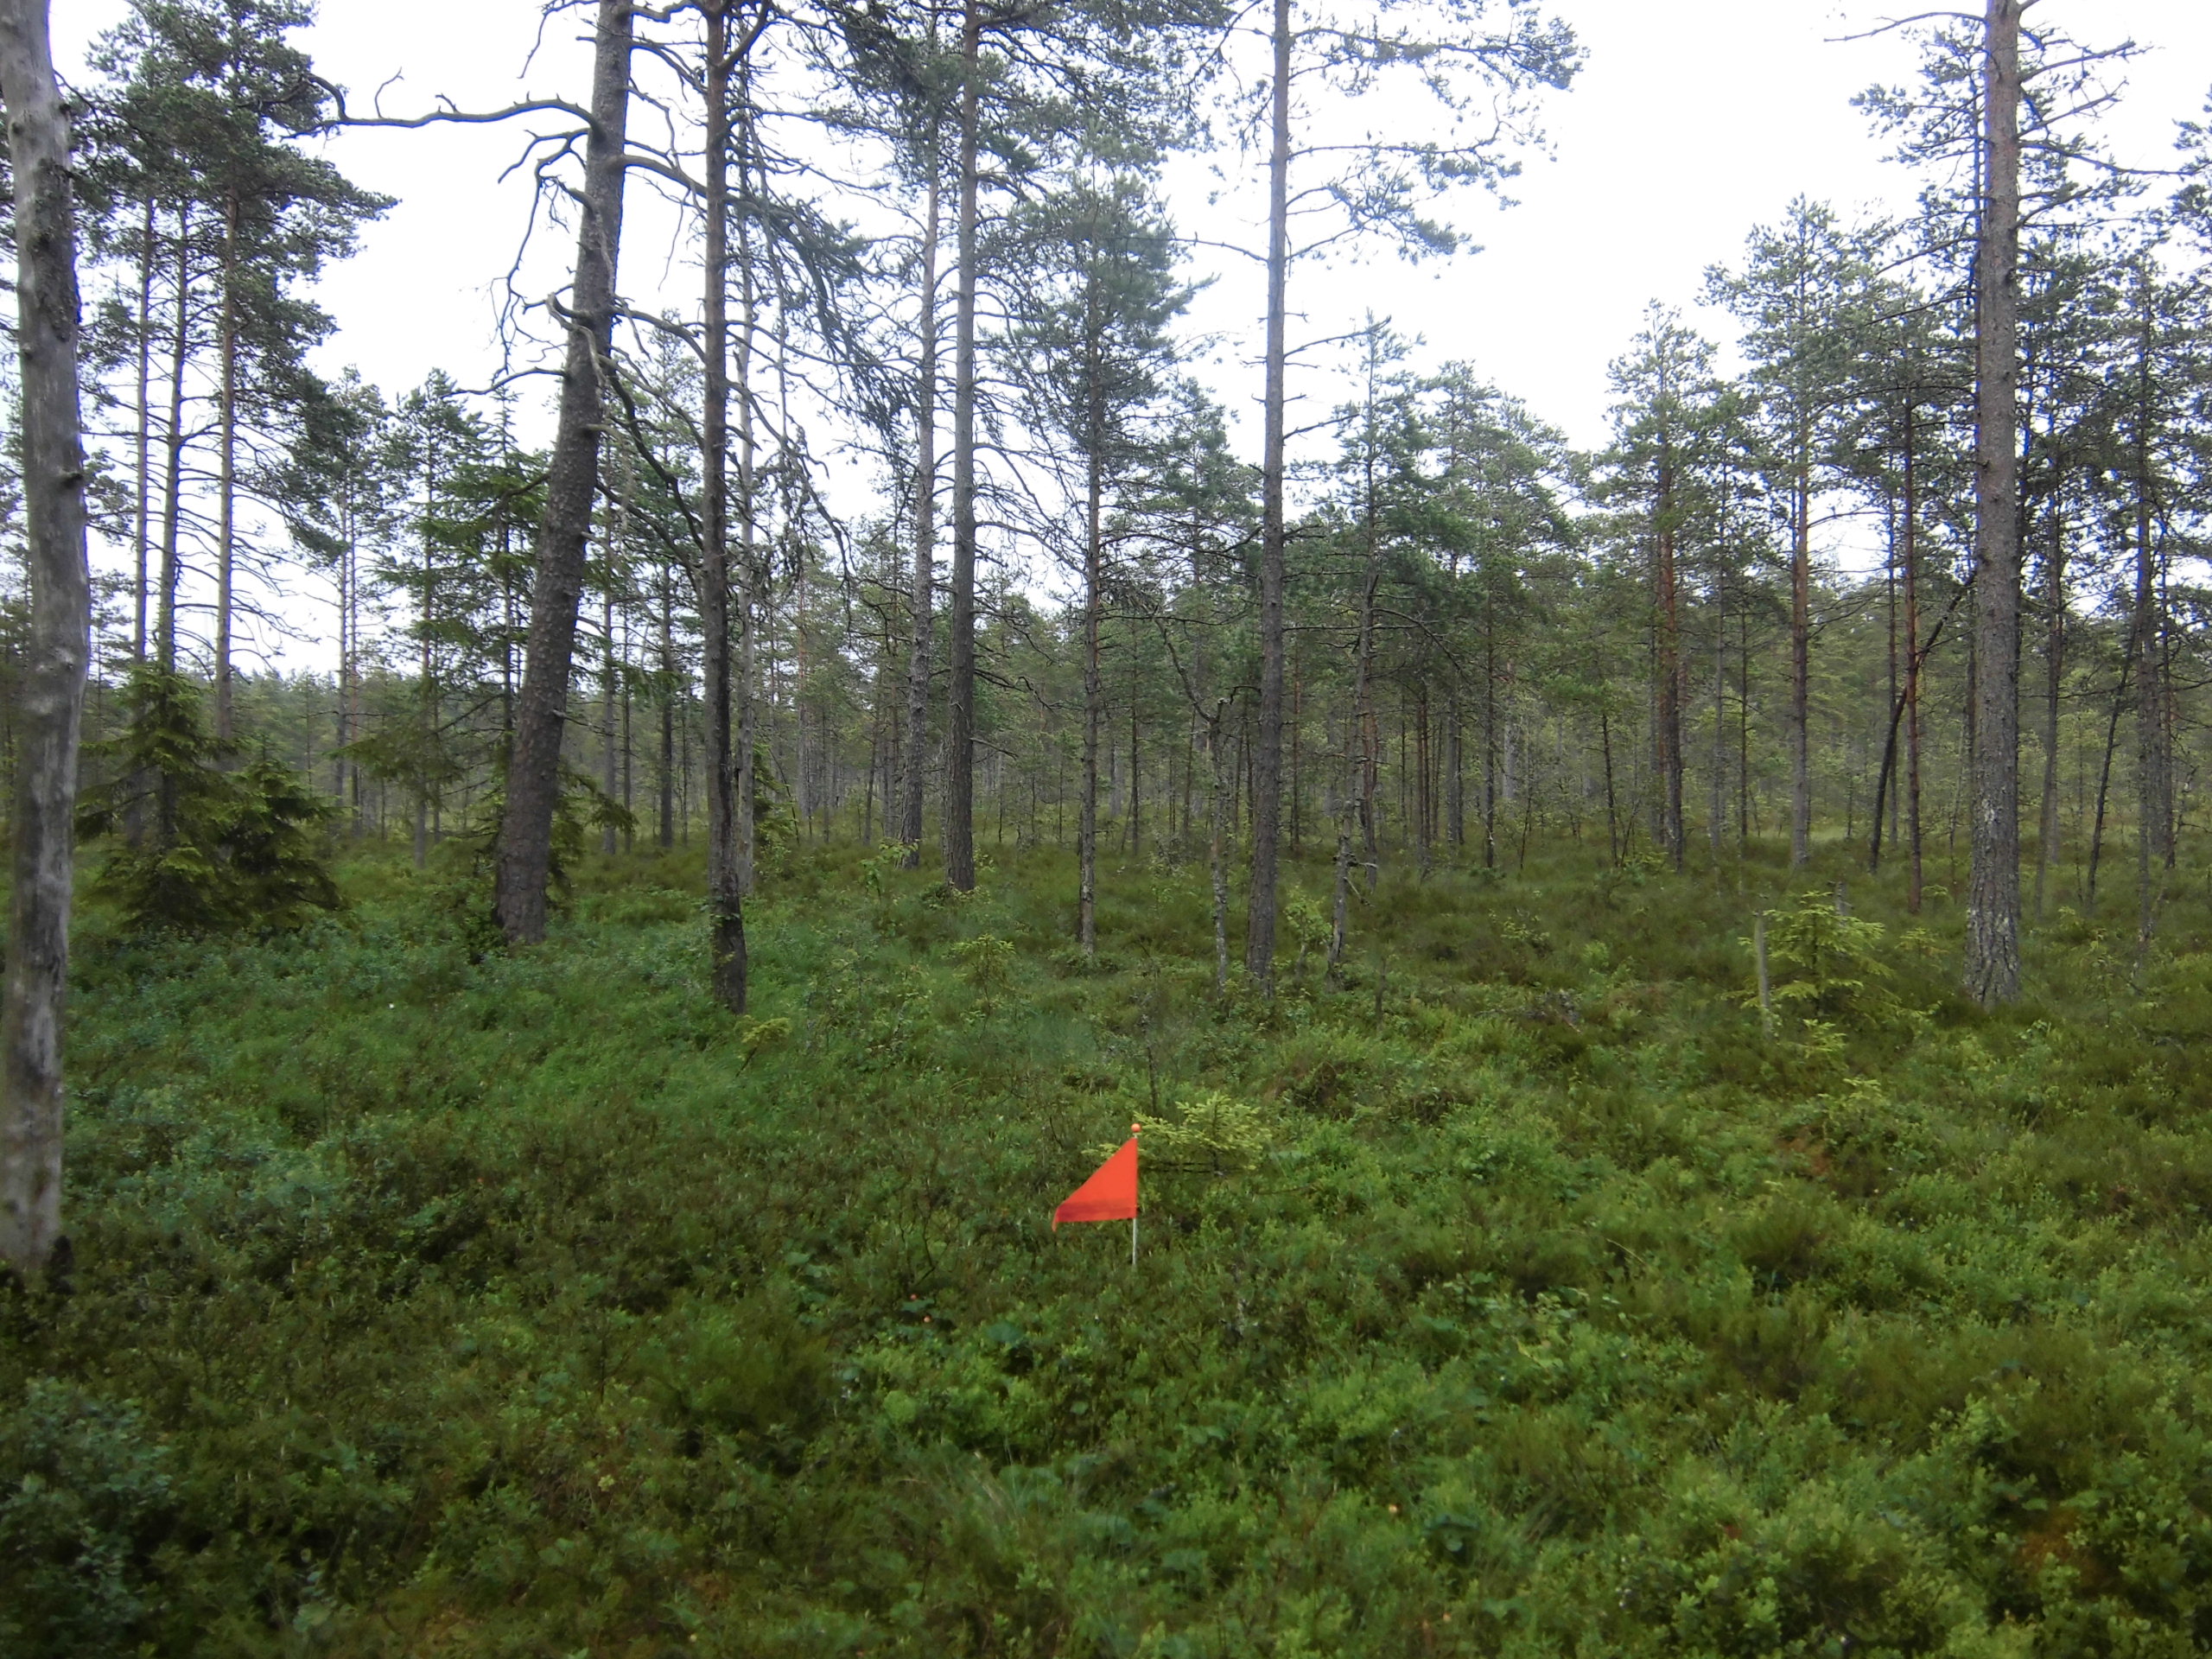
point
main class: Woodland
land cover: Pine dominated coniferous woodland
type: boreal forest
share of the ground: 50 - 75 %
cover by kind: coniferous forest trees 50 %, shrubs 25 %, herbaceous plants 15 %, lichens and mosses 10 %
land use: Forestry
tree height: > 5 m
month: July
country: SE
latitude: 57.2351
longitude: 15.2157
